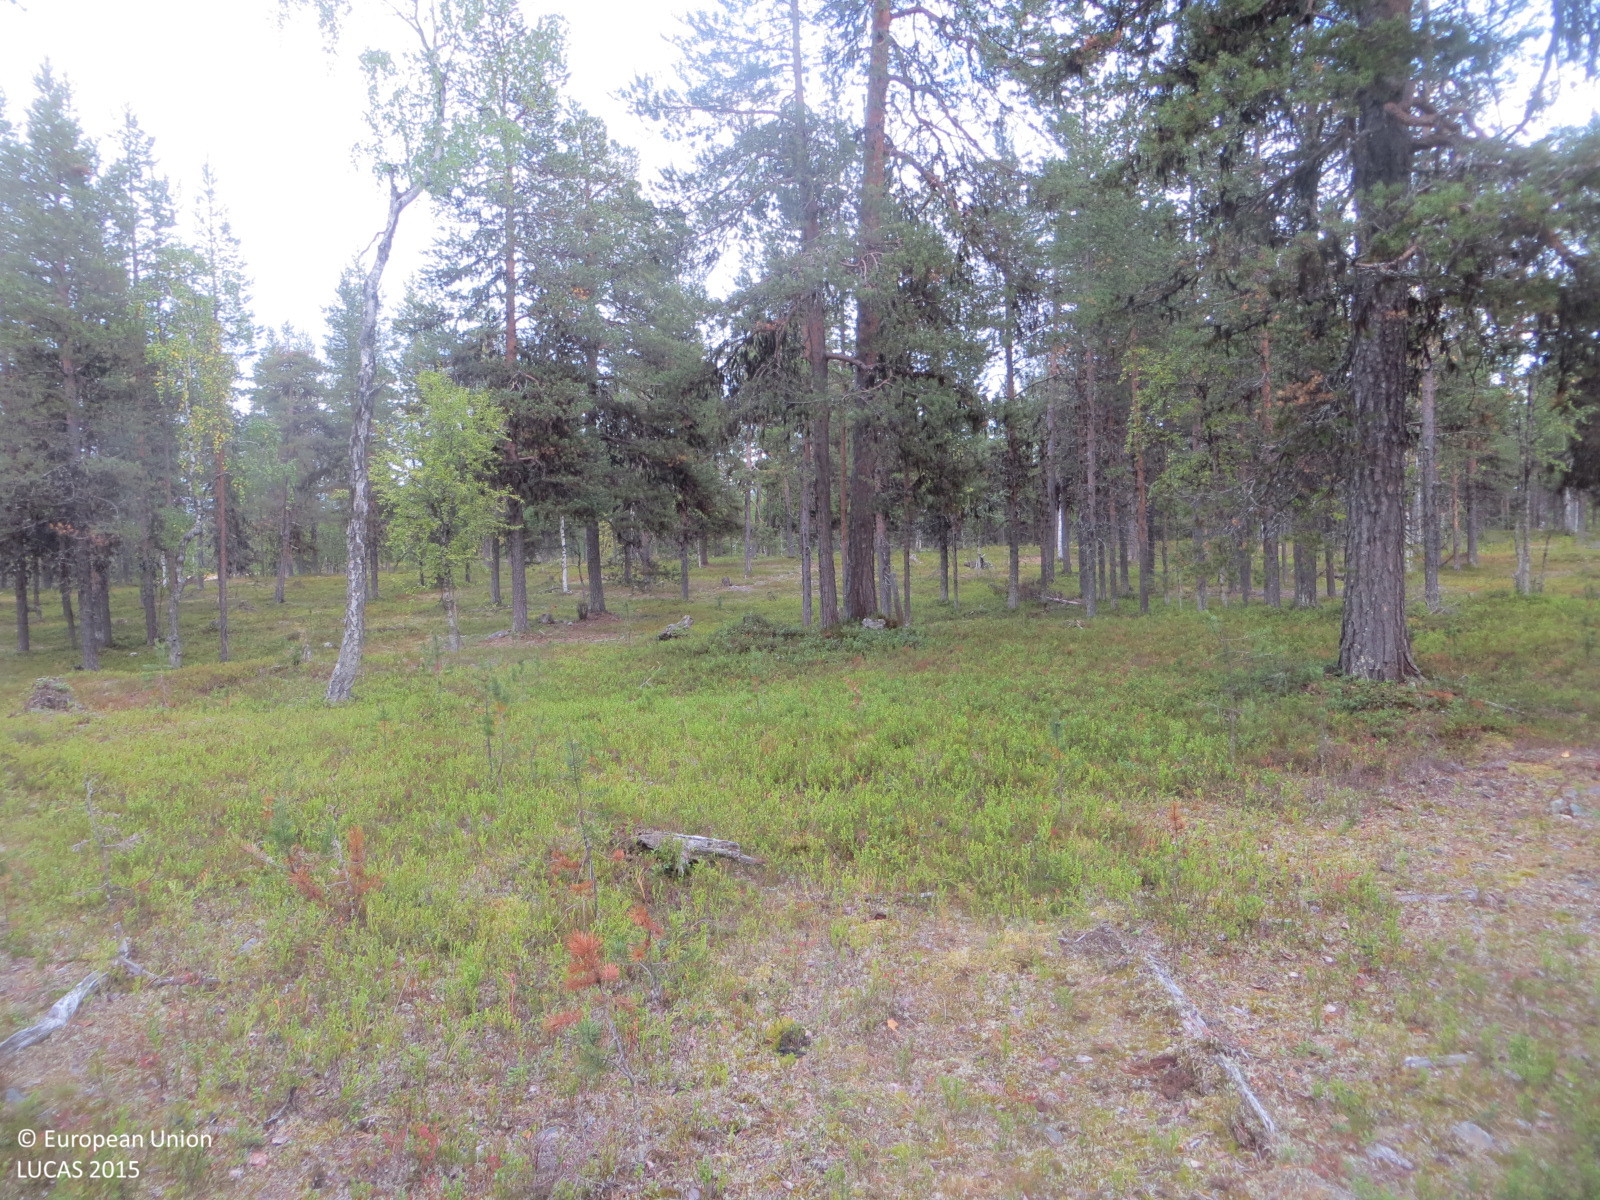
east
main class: Woodland
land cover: Pine dominated mixed woodland
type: boreal forest
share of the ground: 25 - 50 %
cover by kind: shrubs 60 %, coniferous forest trees 30 %, broadleaved forest trees 10 %
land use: Forestry
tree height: > 5 m
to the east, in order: Pine dominated mixed woodland
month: September
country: FI
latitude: 67.9250
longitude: 24.4490
